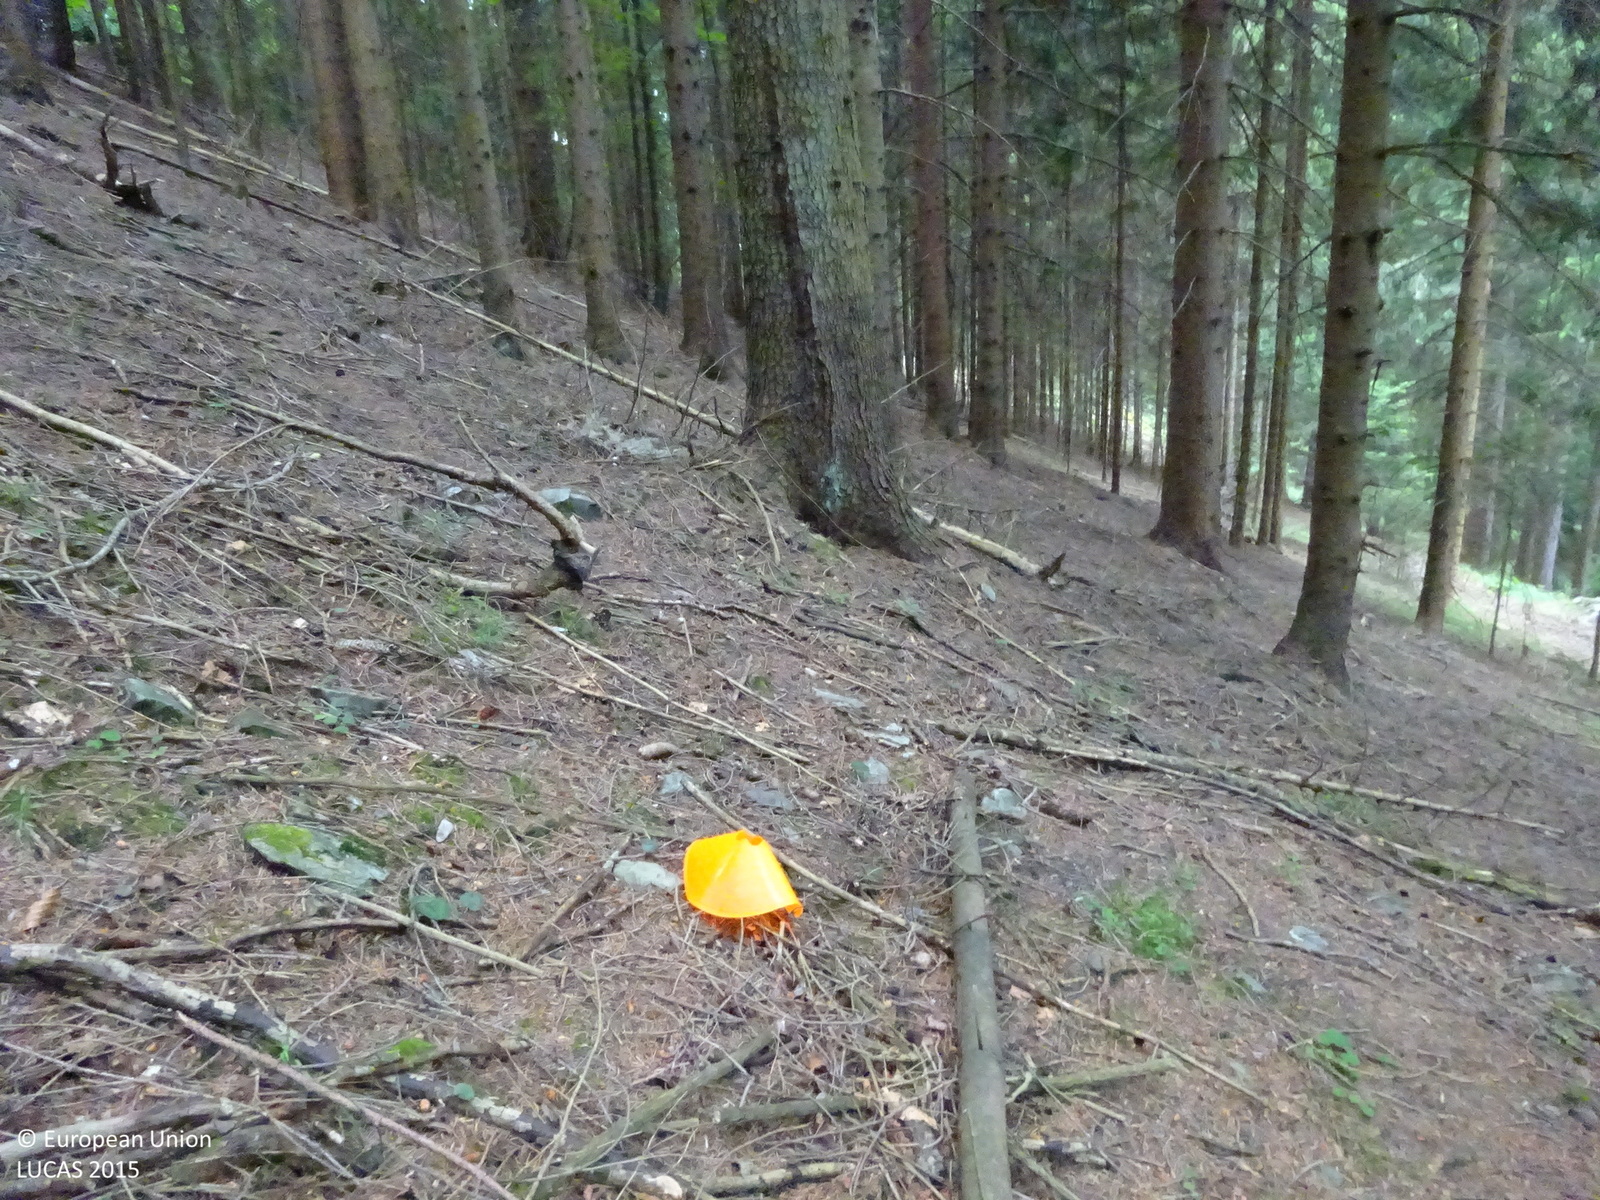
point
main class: Woodland
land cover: Spruce dominated coniferous woodland
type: alpine coniferous forest
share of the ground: > 75 %
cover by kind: coniferous forest trees 100 %
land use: Forestry
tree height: > 5 m
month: July
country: AT
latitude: 47.1881
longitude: 15.4242
